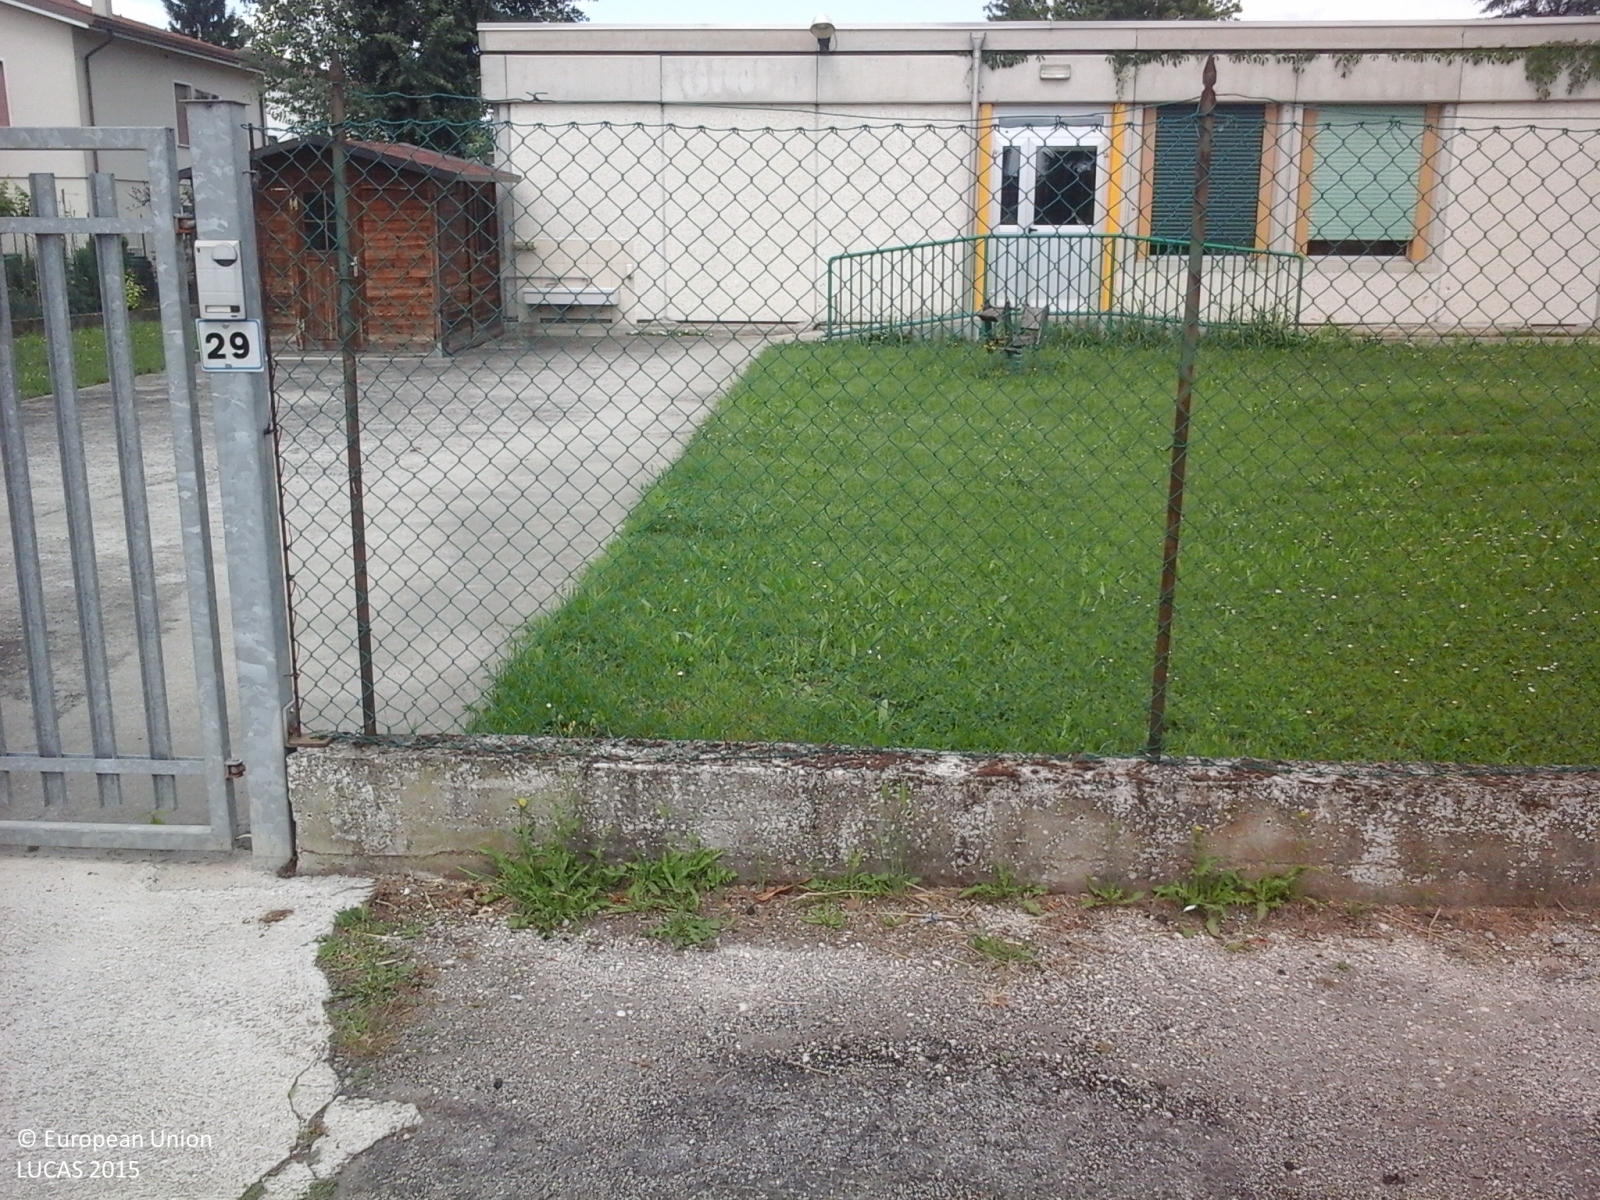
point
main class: Grassland
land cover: Grassland without tree/shrub cover
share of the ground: > 75 %
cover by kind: herbaceous plants 100 %
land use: Community services
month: May
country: IT
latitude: 45.0511
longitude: 10.7477
